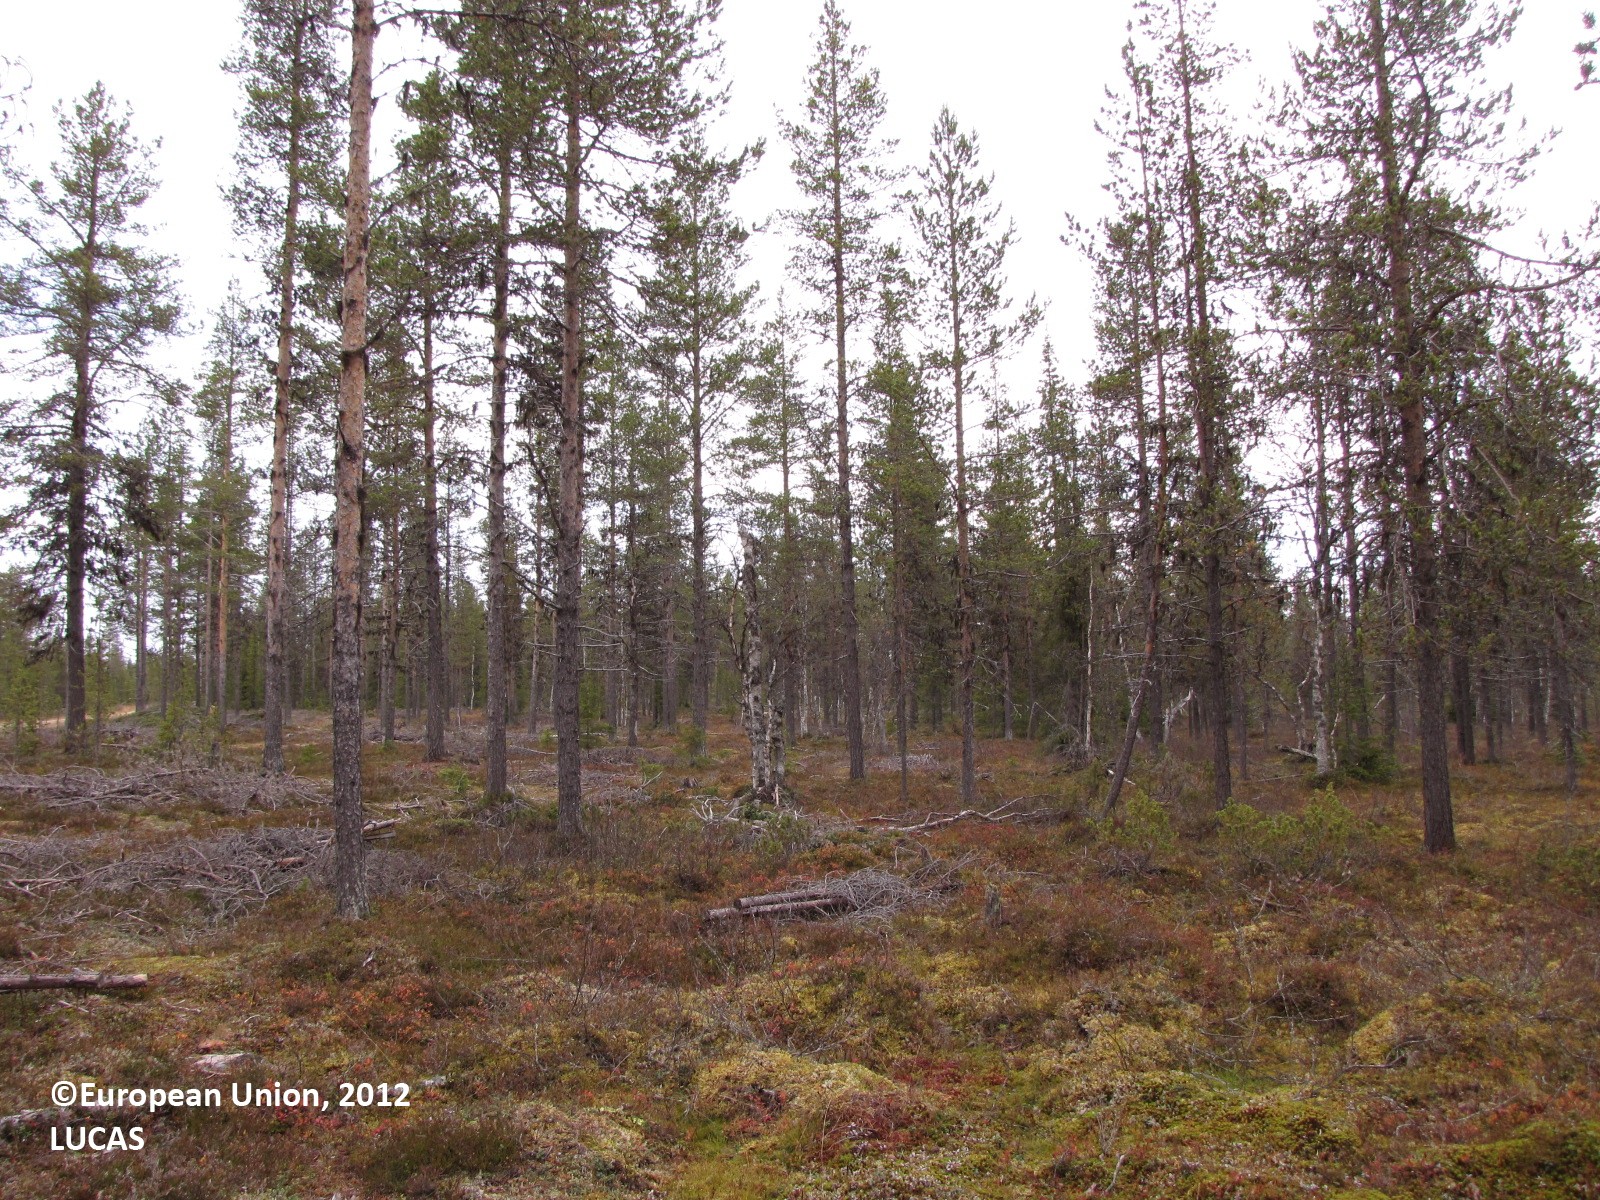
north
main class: Woodland
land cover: Pine dominated coniferous woodland
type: boreal forest
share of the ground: 25 - 50 %
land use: Forestry
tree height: > 5 m
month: September
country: FI
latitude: 67.7104
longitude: 24.1264
